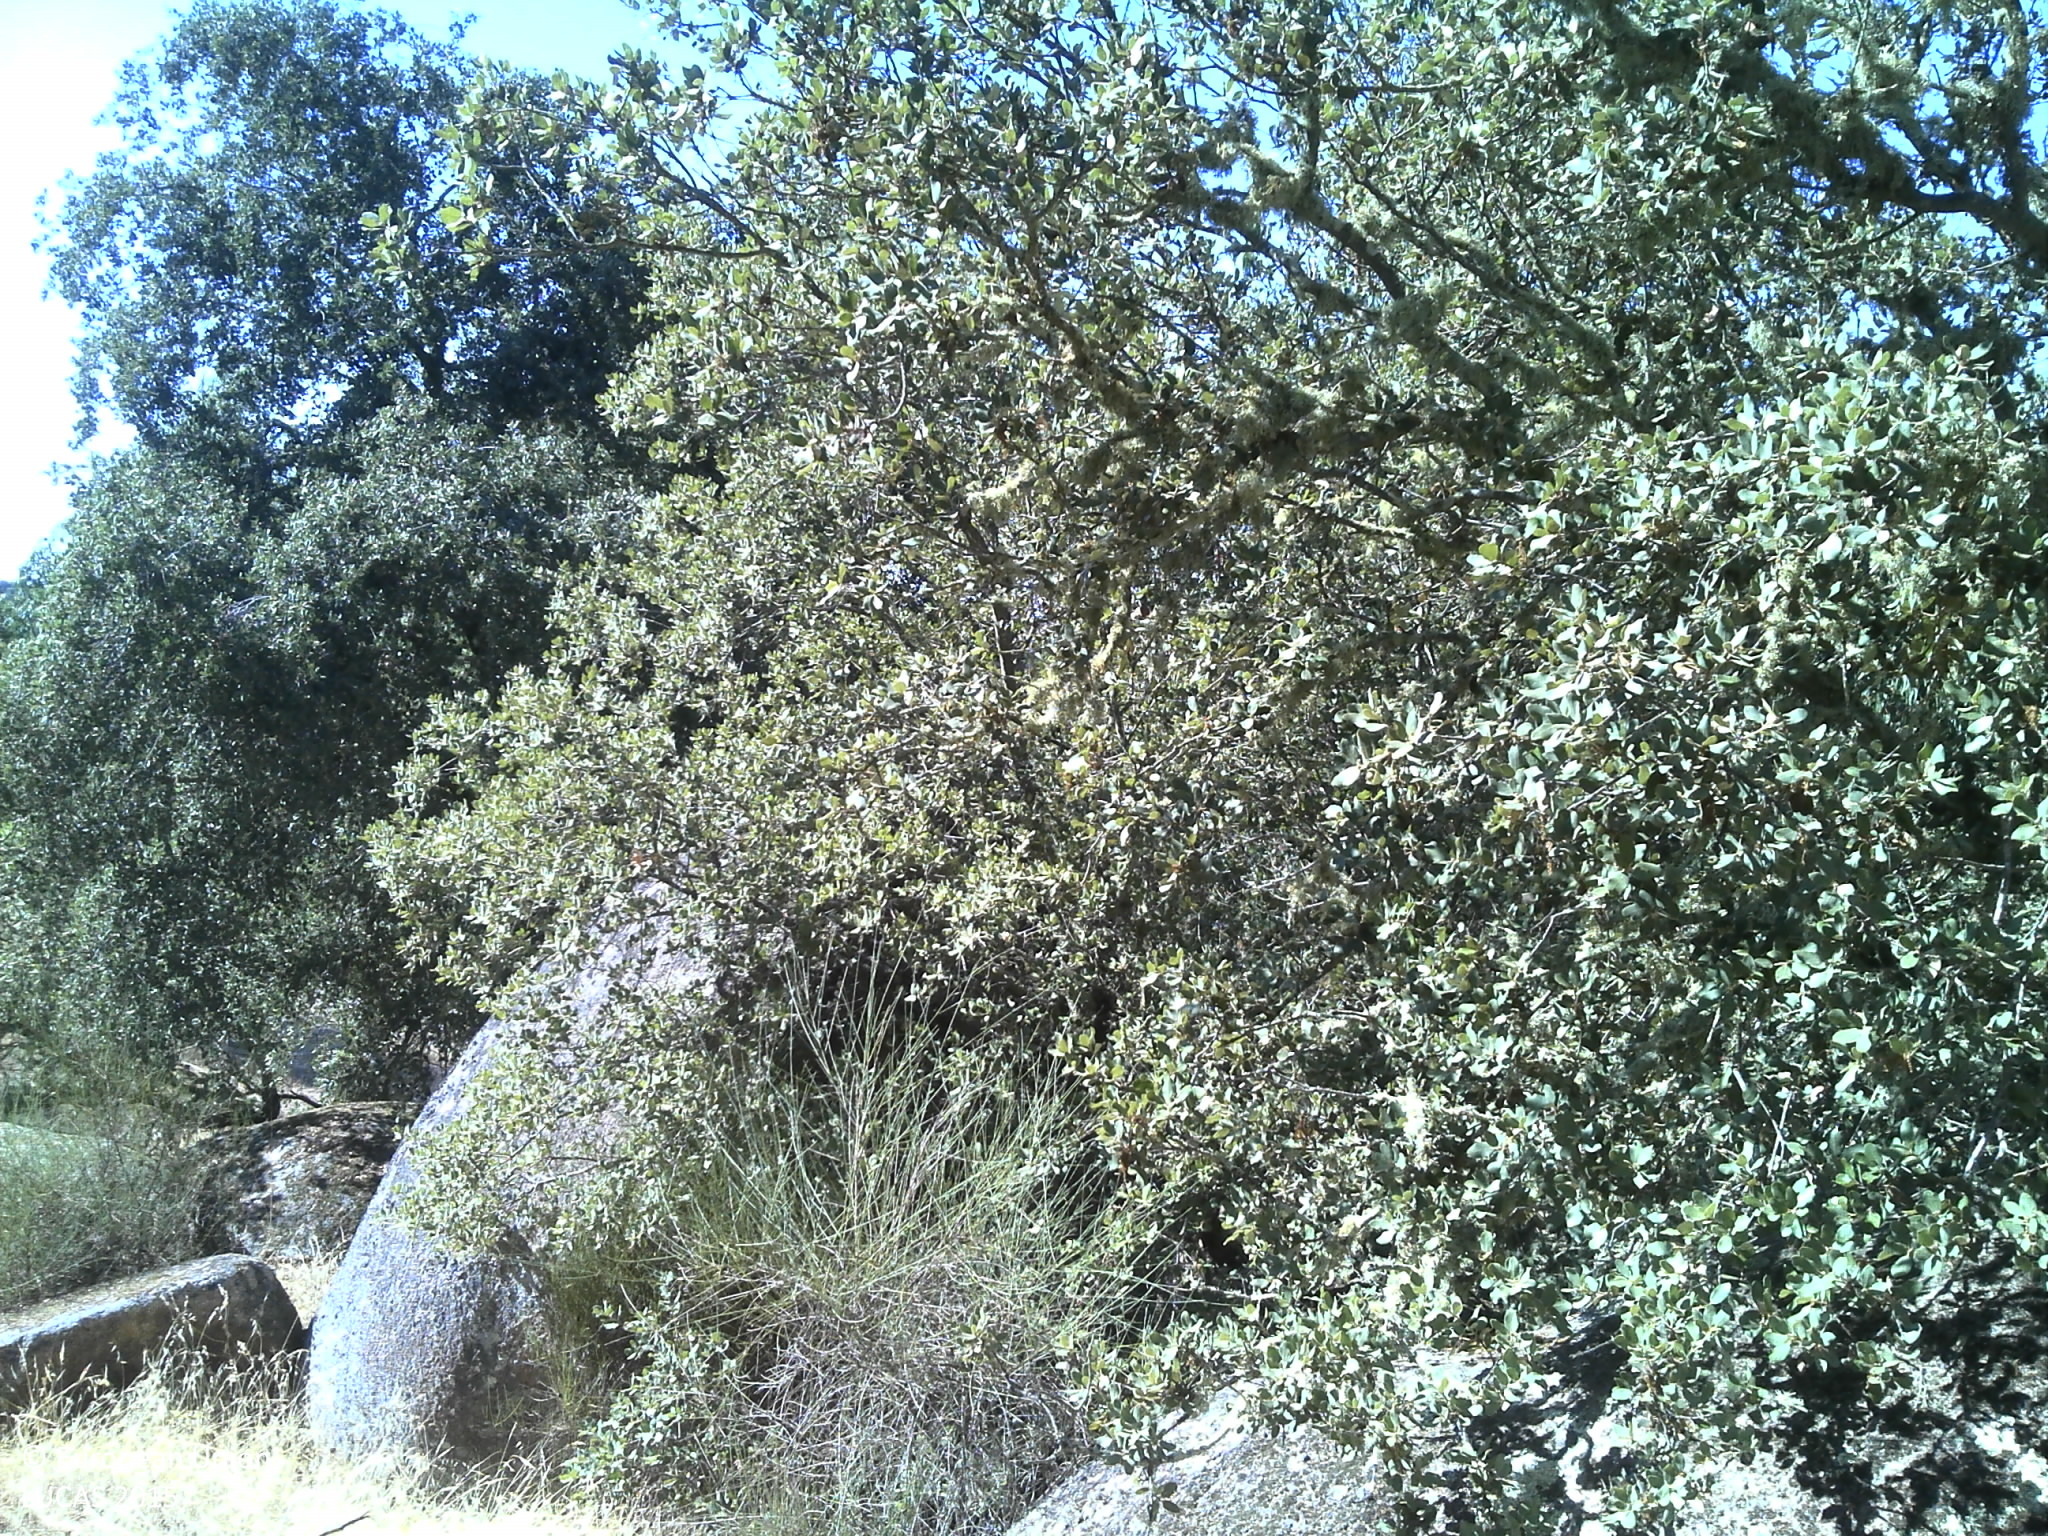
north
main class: Woodland
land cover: Broadleaved woodland
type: exotic forest
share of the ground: 25 - 50 %
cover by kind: unconsolidated bare surface 50 %, broadleaved forest trees 30 %, herbaceous plants 20 %
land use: Forestry
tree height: > 5 m
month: July
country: PT
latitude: 39.0016
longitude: -7.4613
